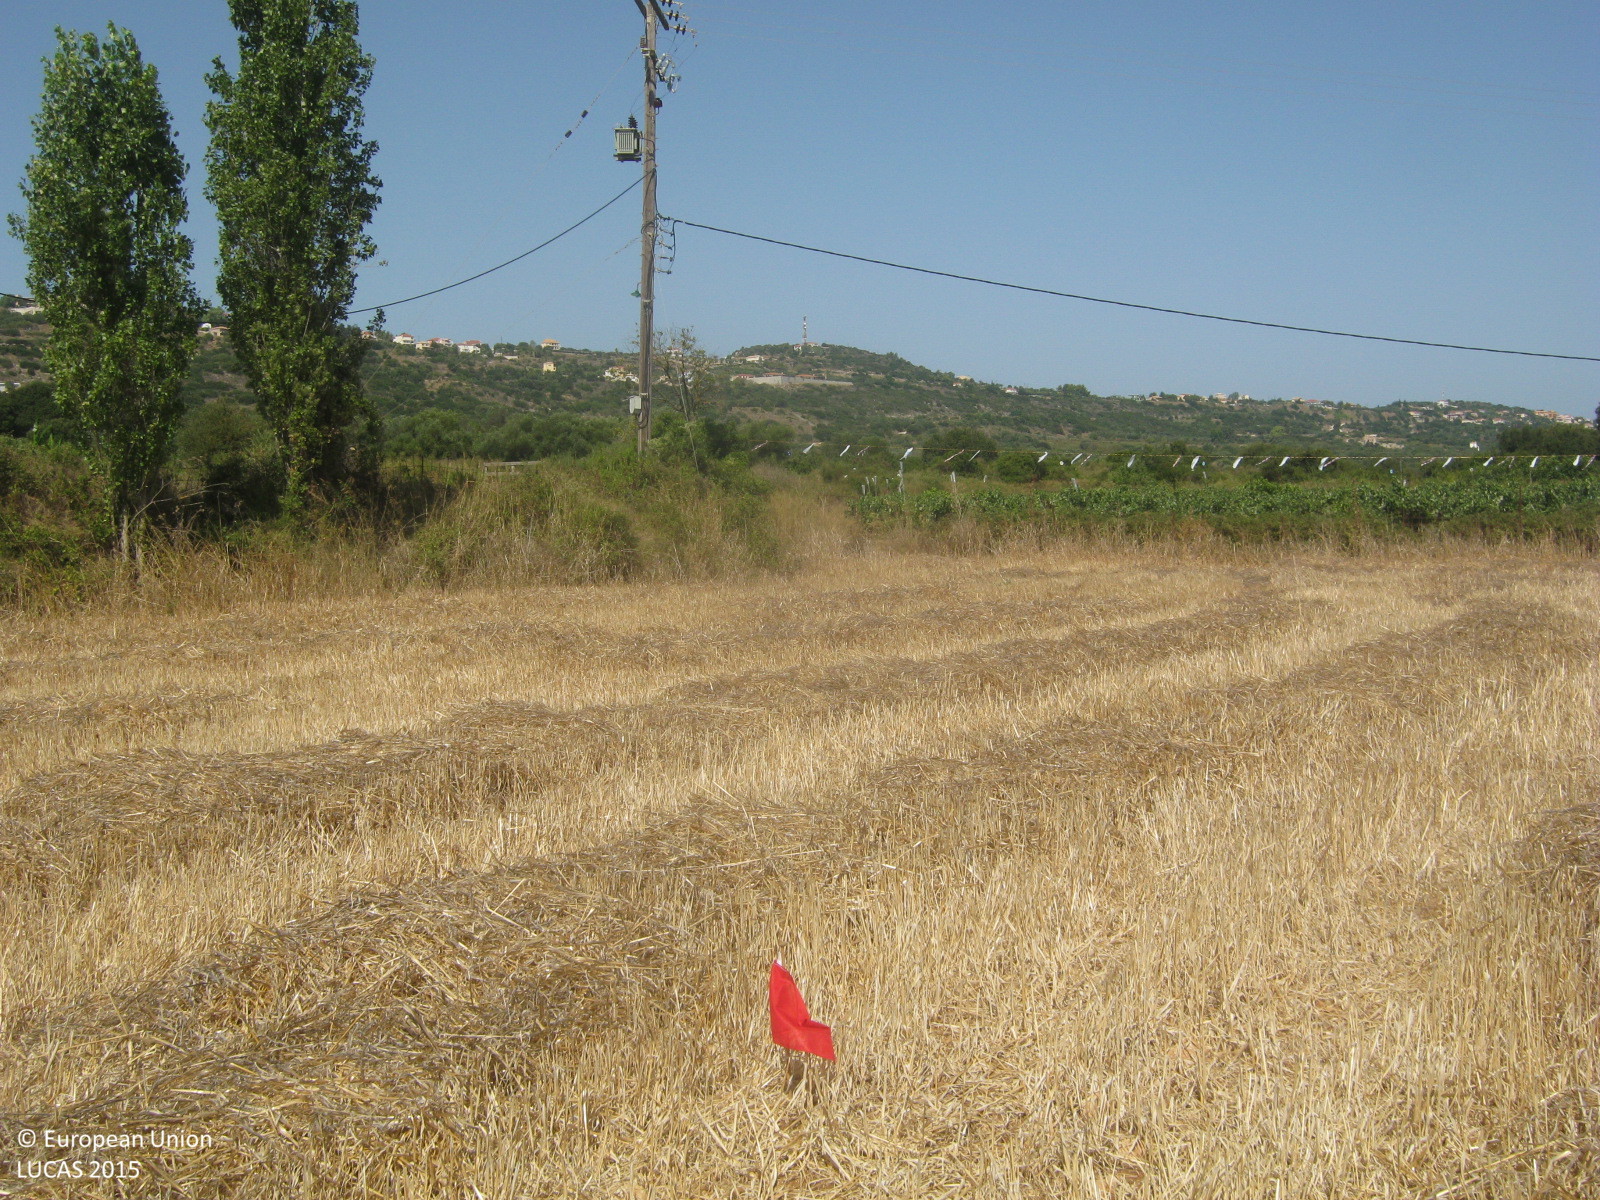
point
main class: Cropland
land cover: Common wheat
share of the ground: > 75 %
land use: Agriculture (excluding fallow land and kitchen gardens)
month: August
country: GR
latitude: 38.1495
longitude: 20.5159
